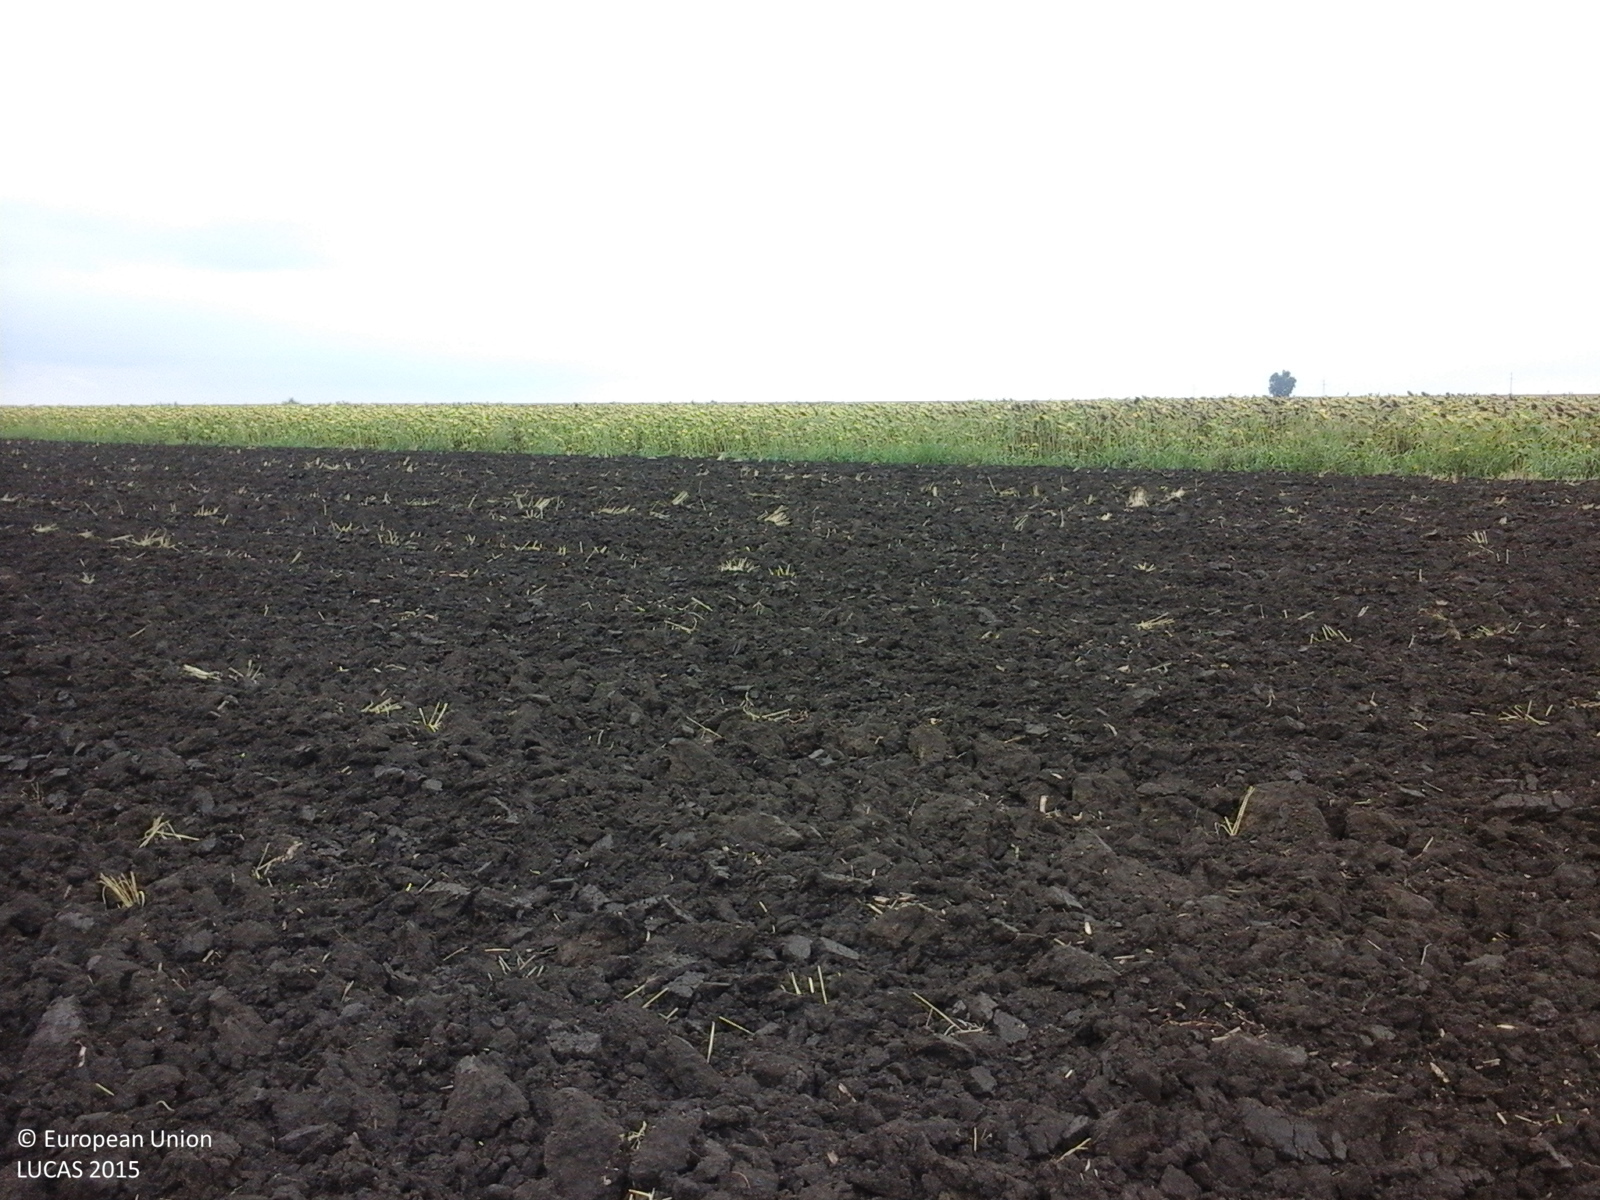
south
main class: Cropland
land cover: Common wheat
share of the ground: < 10 %
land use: Agriculture (excluding fallow land and kitchen gardens)
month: August
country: RO
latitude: 46.0298
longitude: 20.7107
